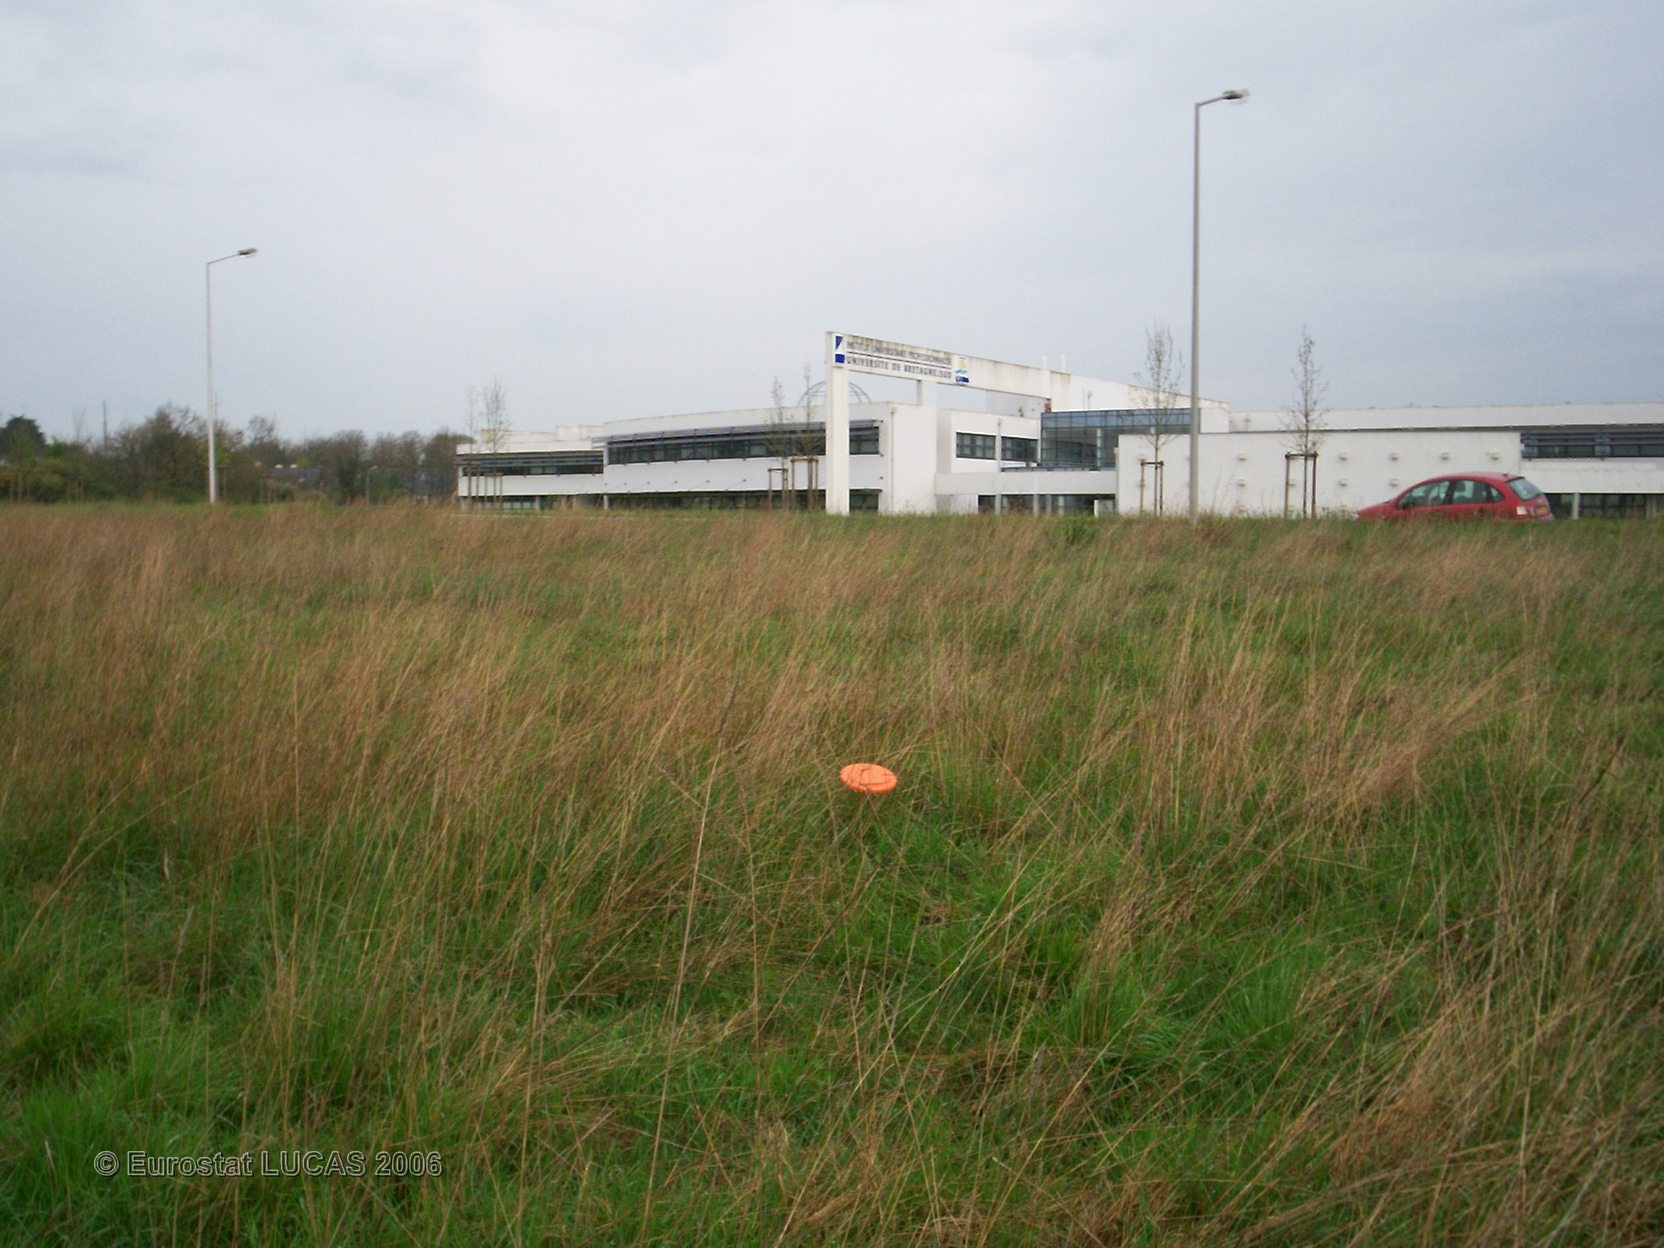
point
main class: Grassland
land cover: Grassland without tree/shrub cover
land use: Agriculture (excluding fallow land and kitchen gardens)
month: April
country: FR
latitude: 47.6438
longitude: -2.7475
